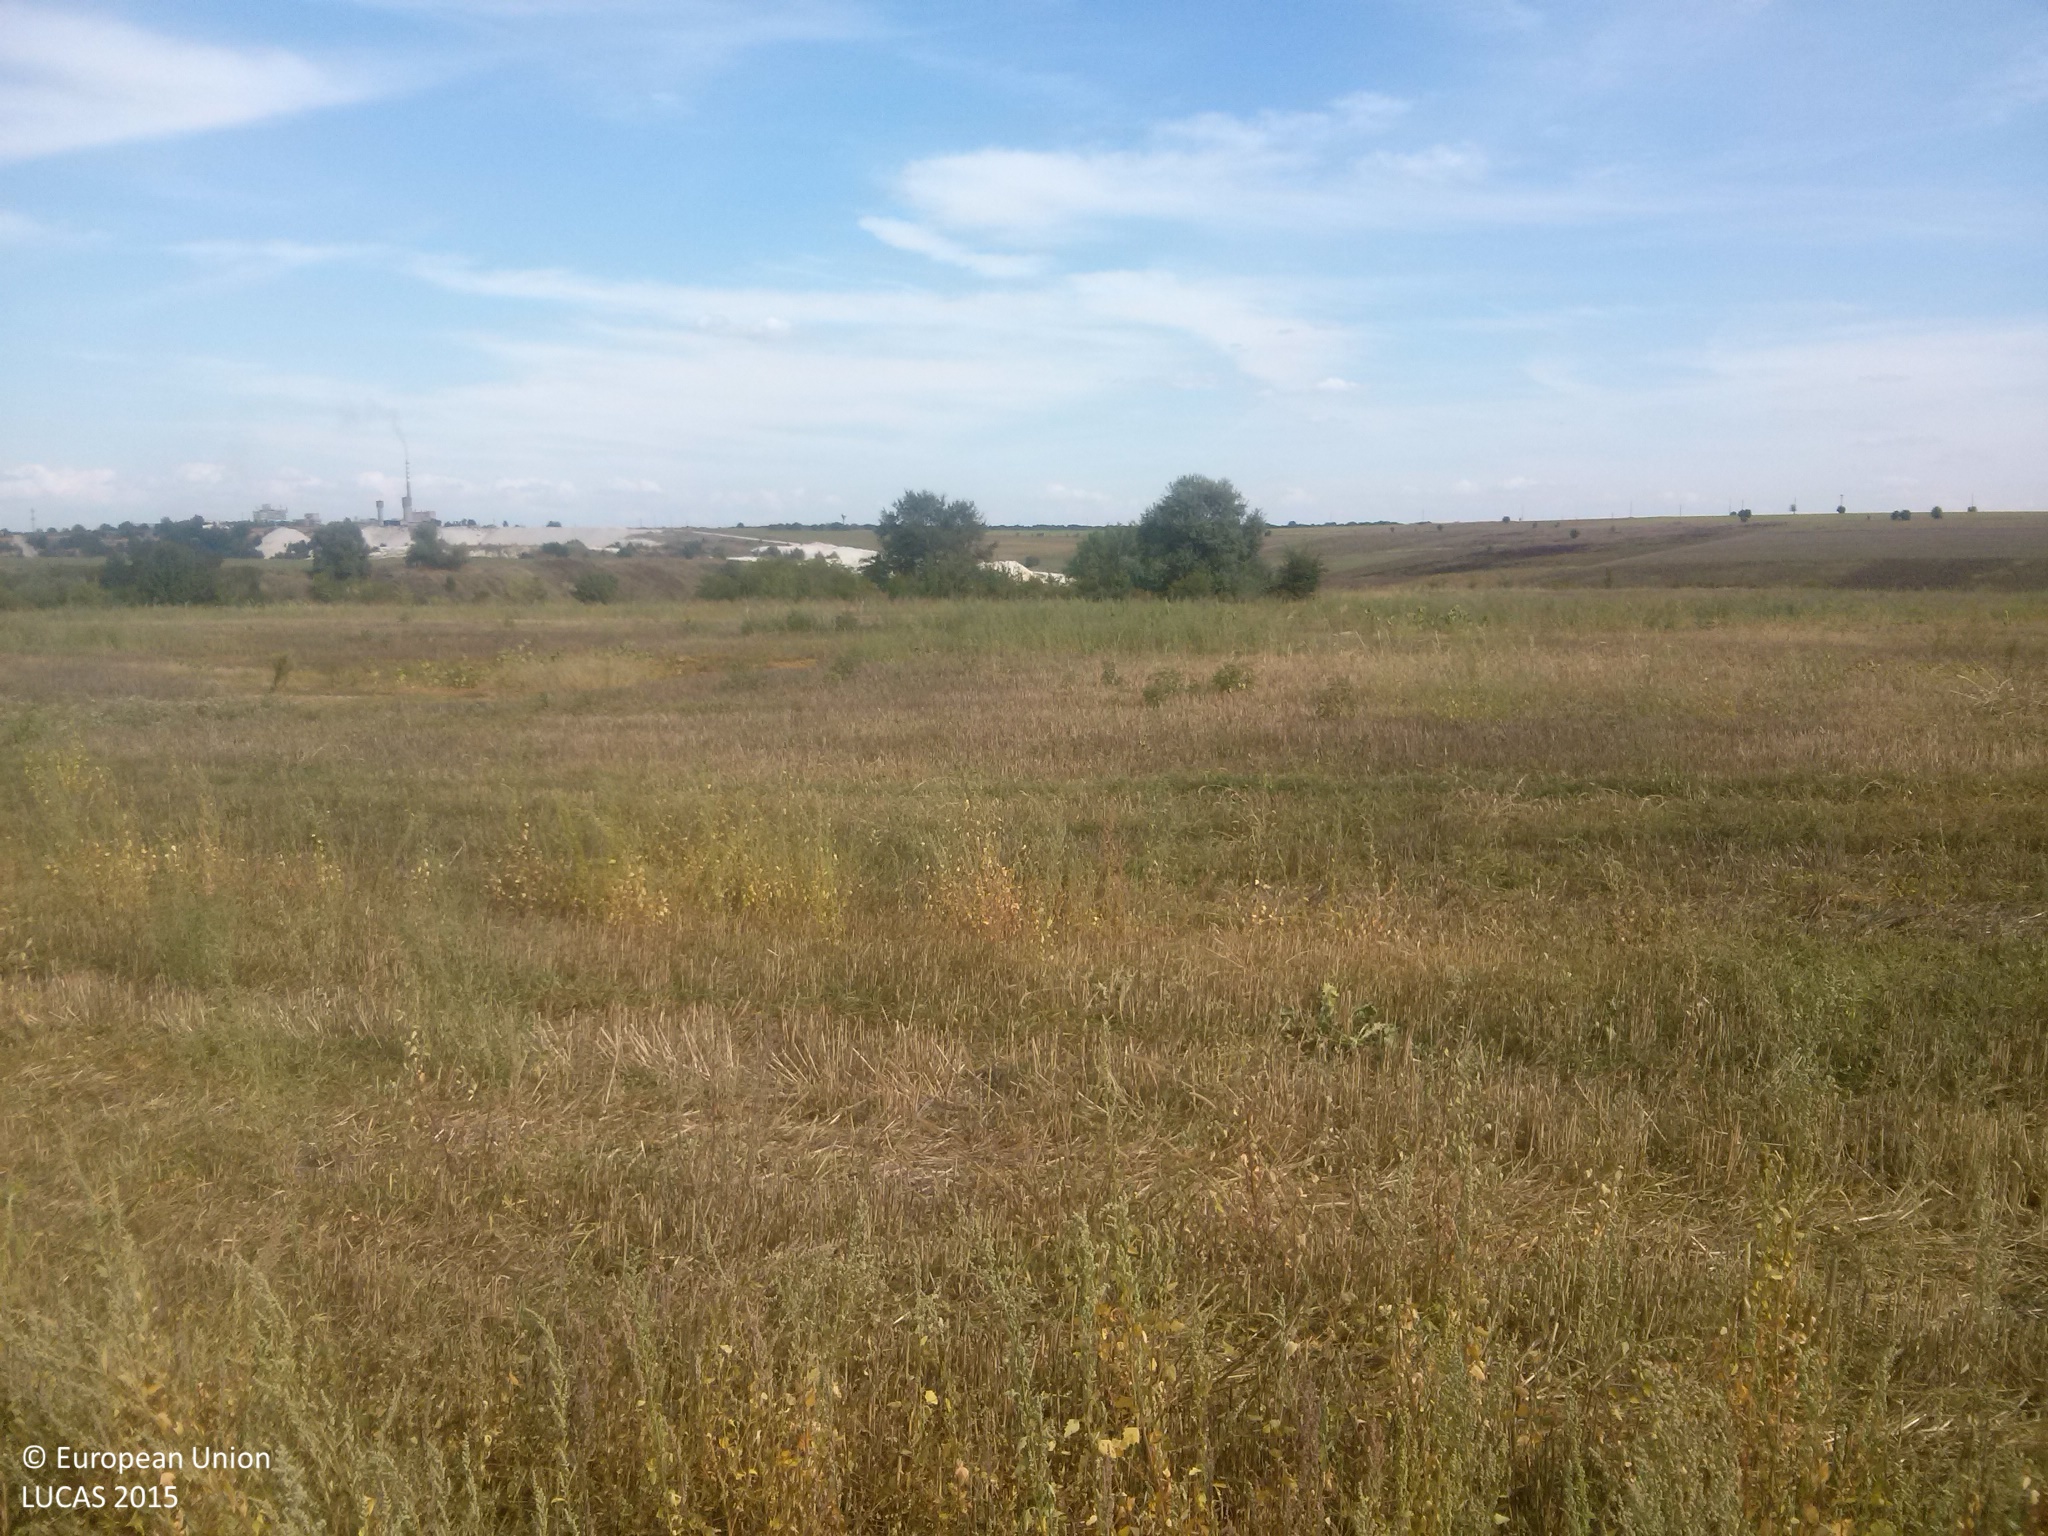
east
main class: Cropland
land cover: Common wheat
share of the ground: 25 - 50 %
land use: Agriculture (excluding fallow land and kitchen gardens)
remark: Harvested field
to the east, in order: Common wheat; Grassland without tree/shrub cover; Shrubland without tree cover; Grassland without tree/shrub cover; Shrubland with sparse tree cover; Grassland without tree/shrub cover
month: September
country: BG
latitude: 43.6855
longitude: 26.2400
